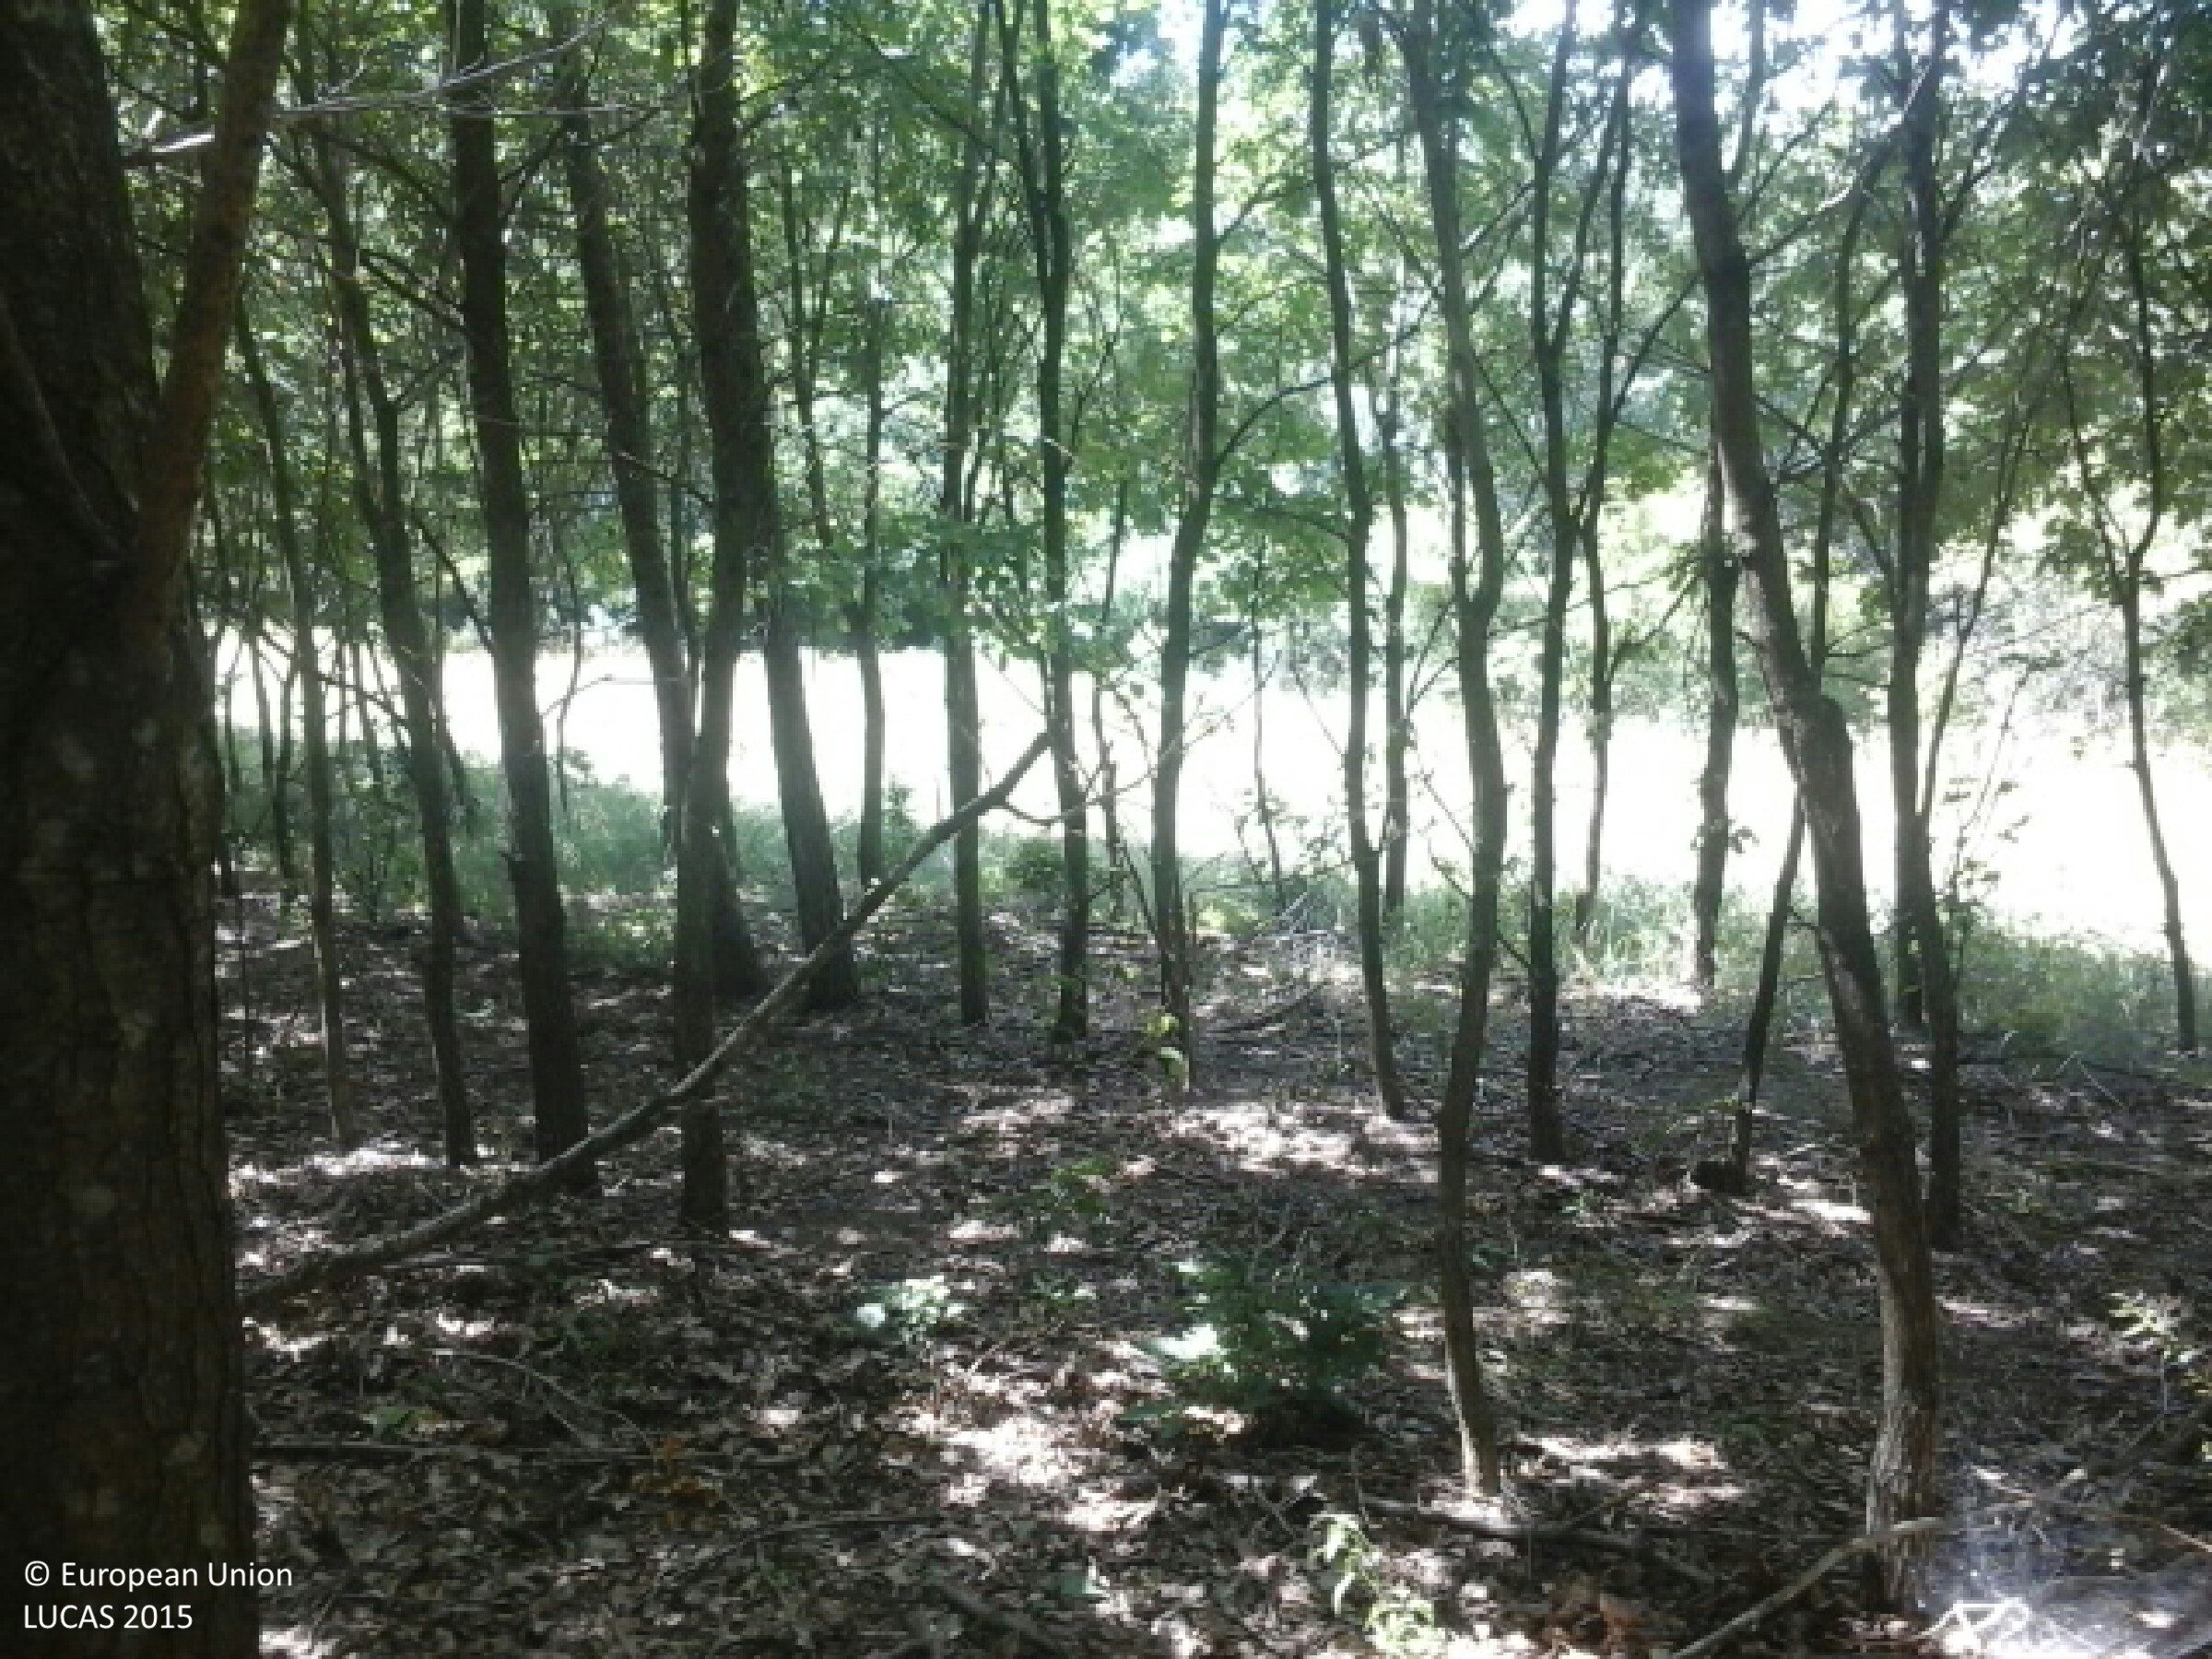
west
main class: Woodland
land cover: Broadleaved woodland
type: mesophytic deciduous forest
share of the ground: > 75 %
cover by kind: broadleaved forest trees 95 %, coniferous forest trees 5 %
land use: Forestry
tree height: > 5 m
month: July
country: HU
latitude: 48.4442
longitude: 21.6069
